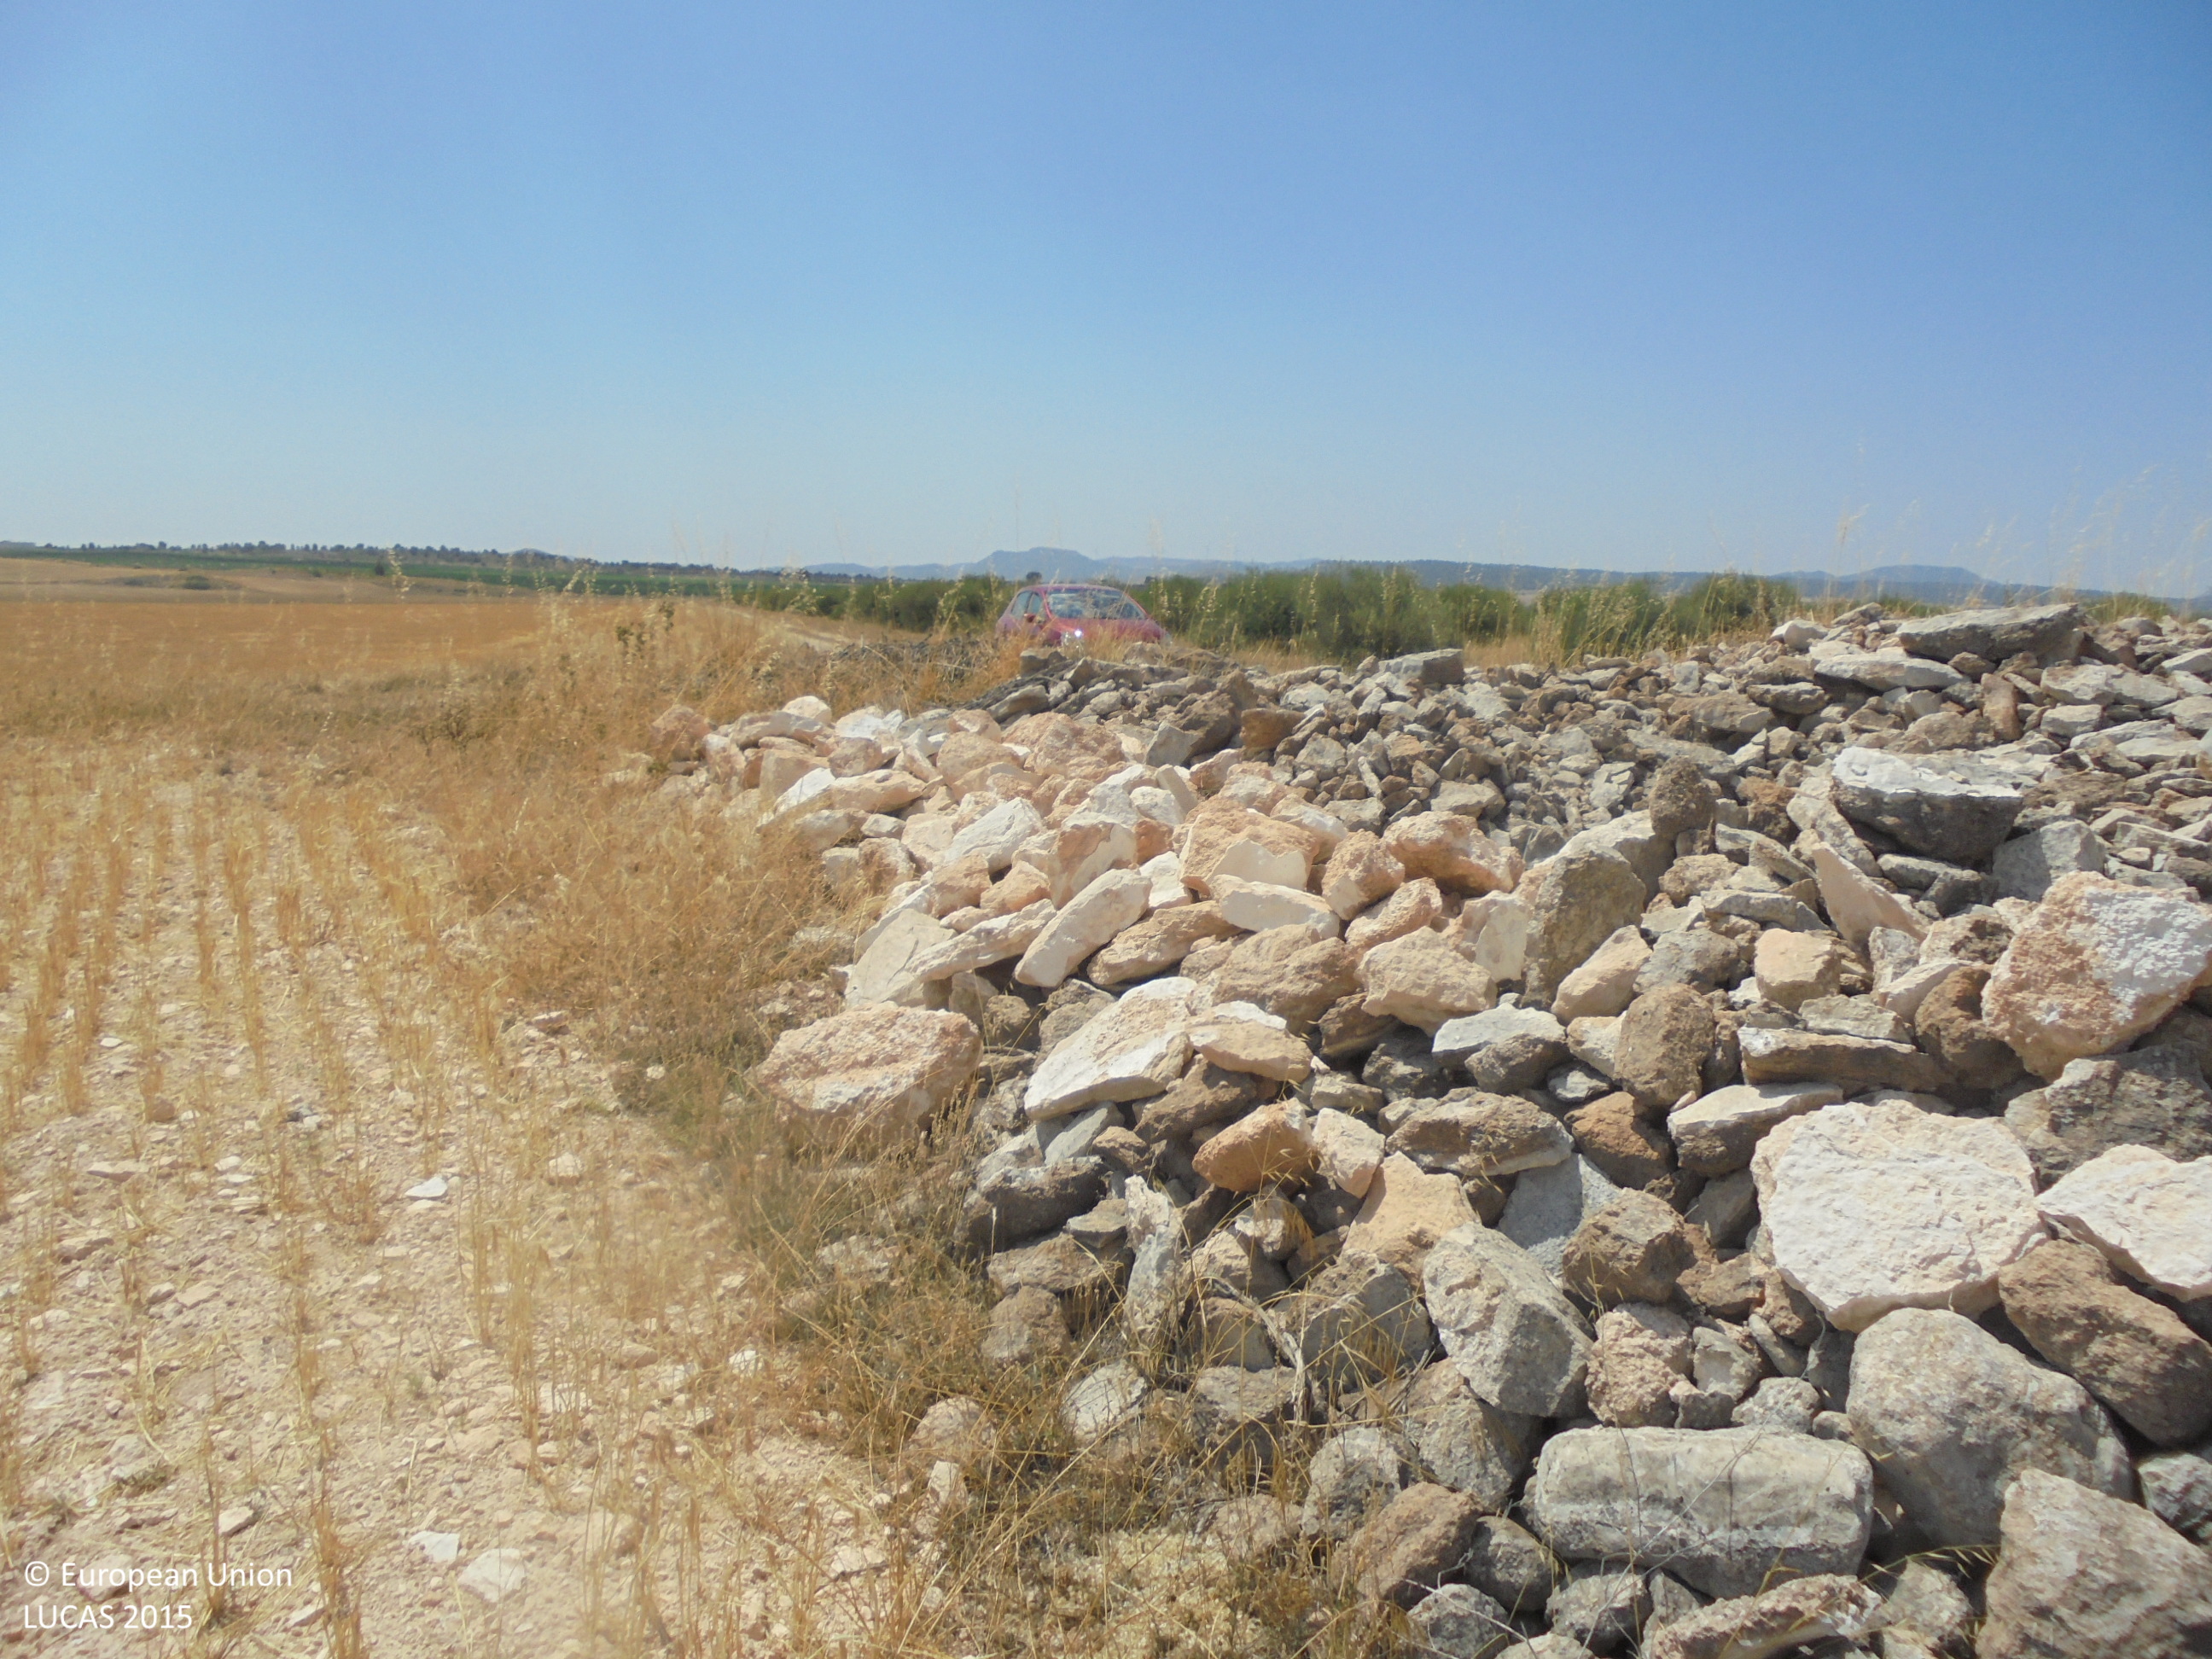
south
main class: Cropland
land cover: Barley
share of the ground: < 10 %
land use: Agriculture (excluding fallow land and kitchen gardens)
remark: Harvested field
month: July
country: ES
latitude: 38.5966
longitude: -1.3940
